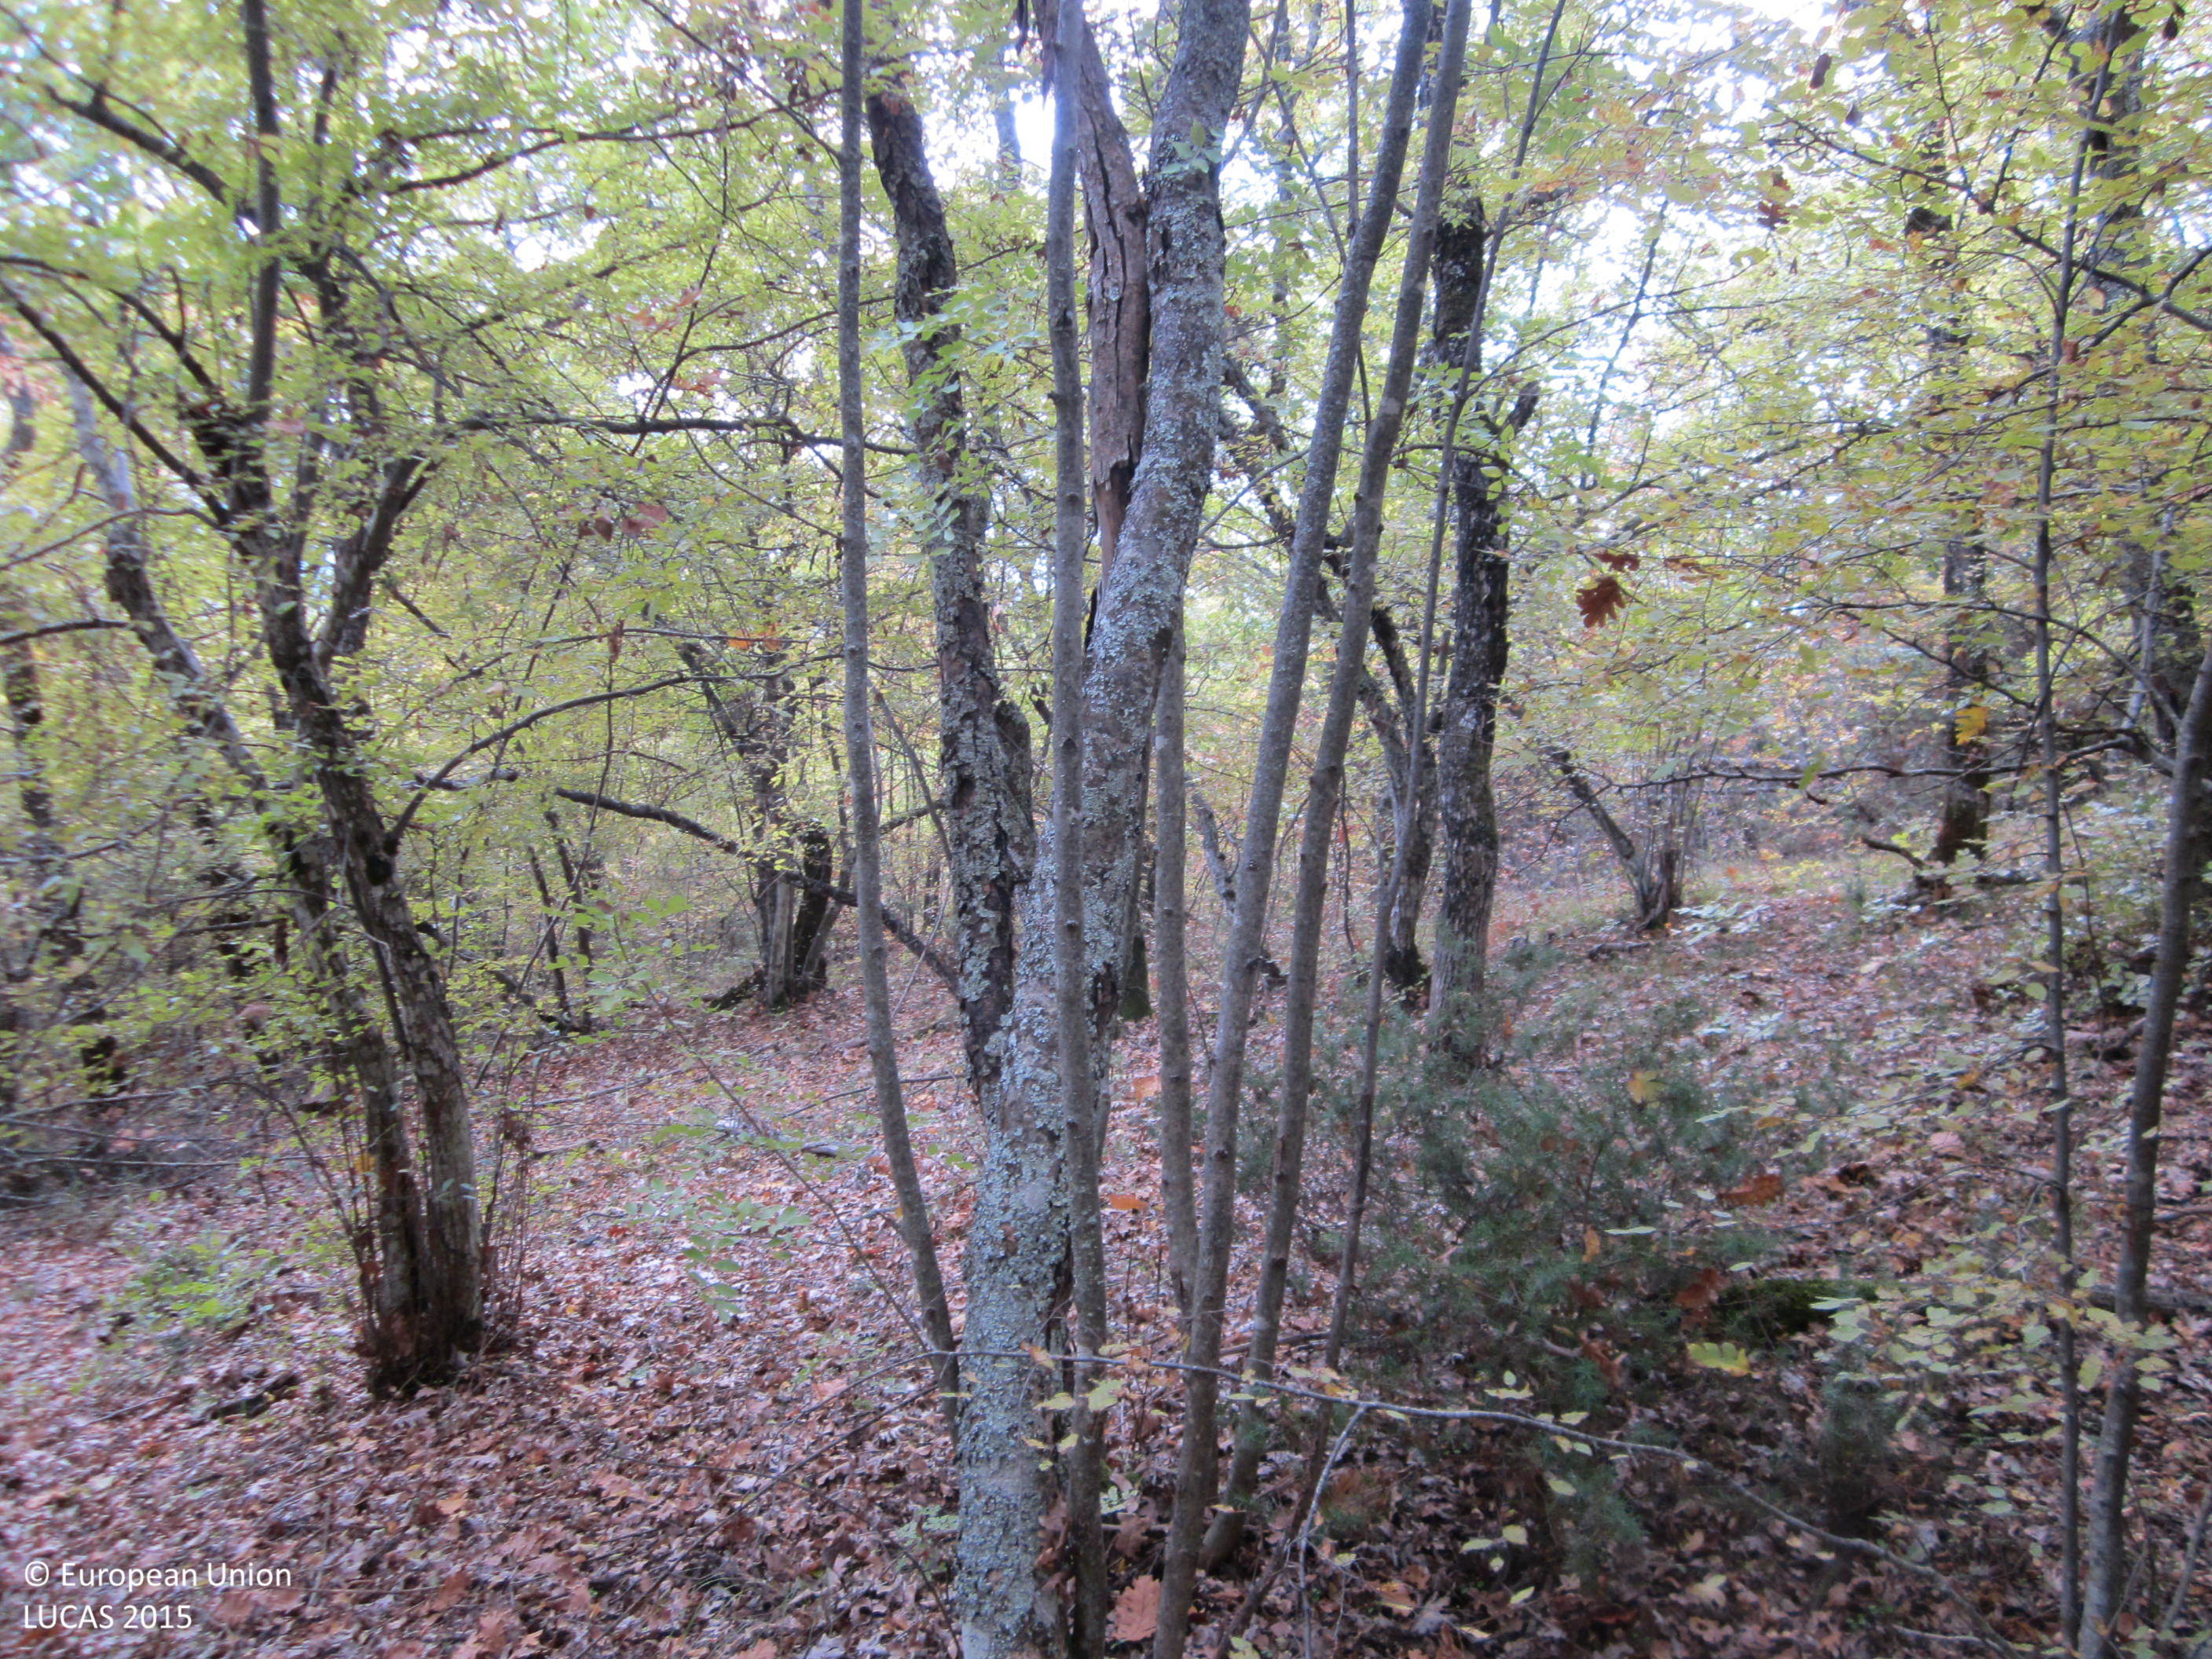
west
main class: Woodland
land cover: Broadleaved woodland
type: mesophytic deciduous forest
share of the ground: > 75 %
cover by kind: broadleaved forest trees 80 %, unconsolidated bare surface 10 %, shrubs 5 %, lichens and mosses 5 %
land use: Forestry
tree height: > 5 m
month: November
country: BG
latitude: 41.4400
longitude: 25.9235
